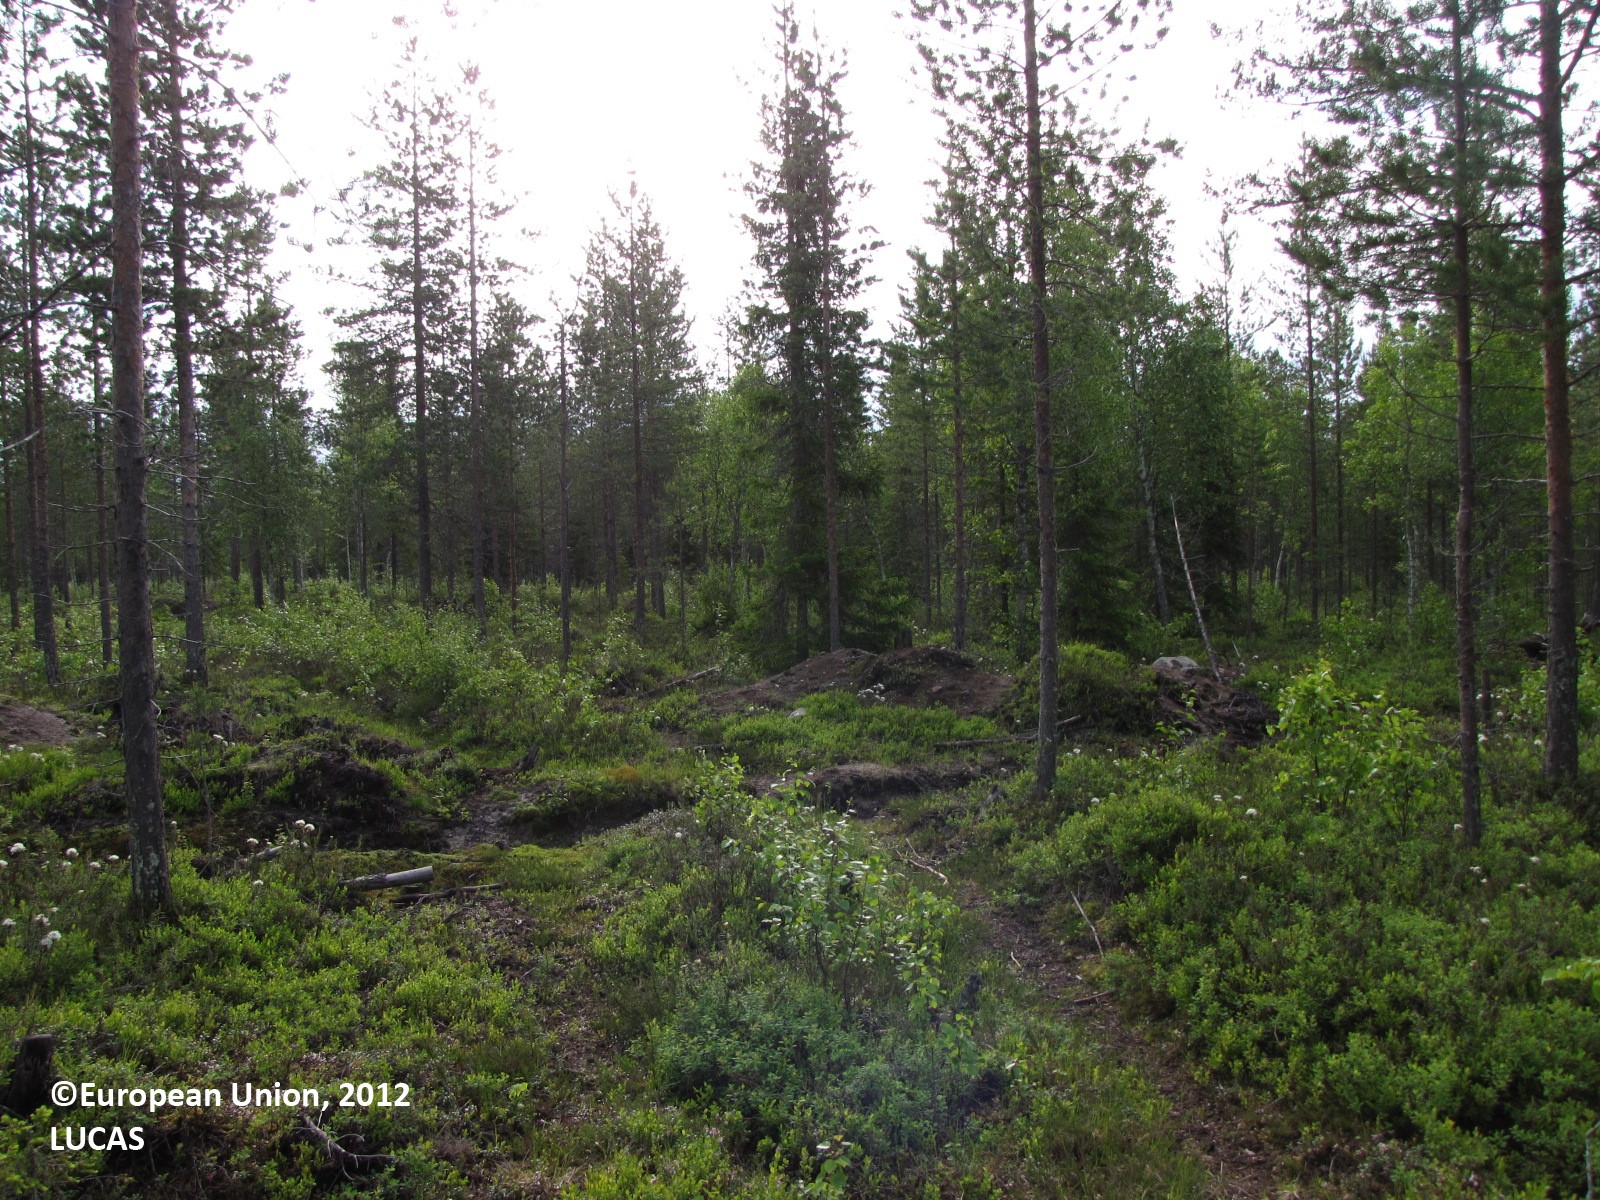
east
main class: Woodland
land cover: Pine dominated coniferous woodland
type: boreal forest
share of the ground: 50 - 75 %
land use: Forestry
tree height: > 5 m
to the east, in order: Pine dominated coniferous woodland; Ditches and canals; Spruce dominated coniferous woodland; Ditches and canals; Spruce dominated coniferous woodland; Ditches and canals; Other mixed woodland; Ditches and canals; Other mixed woodland; Ditches and canals; Spruce dominated mixed woodland; Ditches and canals; Spruce dominated mixed woodland; Ditches and canals; Spruce dominated coniferous woodland; Tracks; Spruce dominated coniferous woodland; Ditches and canals; Pine dominated mixed woodland
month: June
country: FI
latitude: 66.4221
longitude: 24.4962
